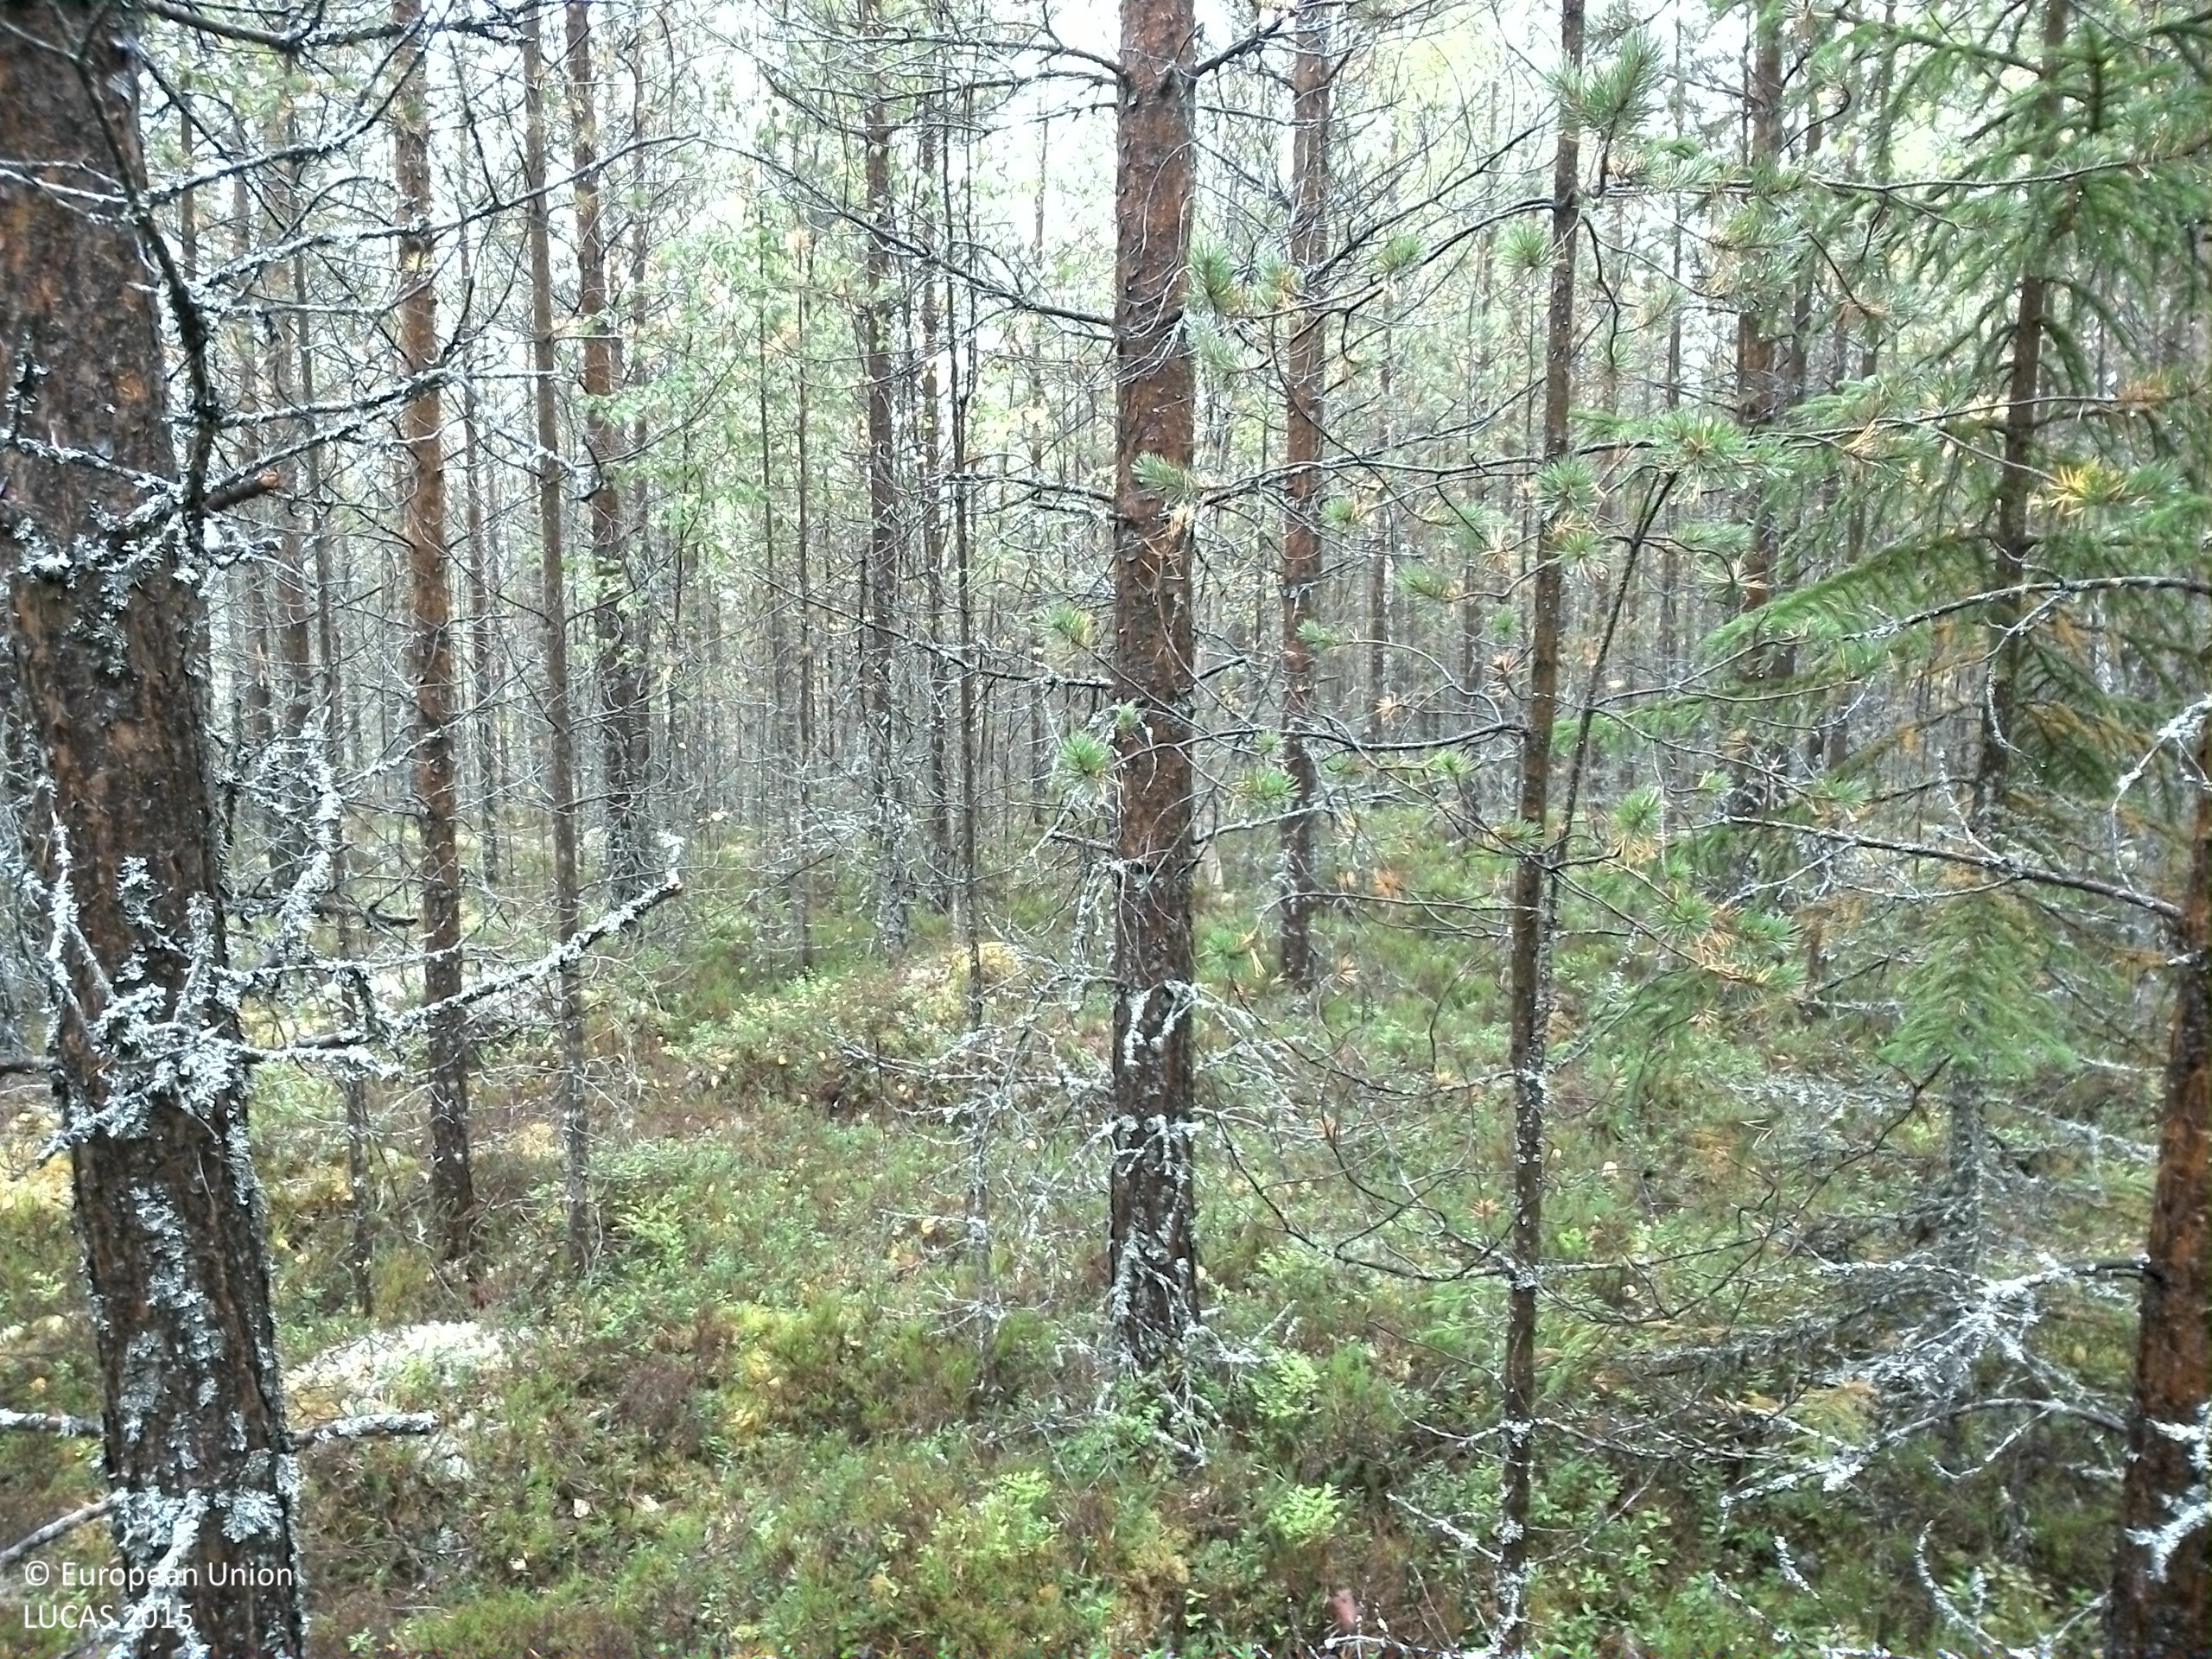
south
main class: Woodland
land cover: Pine dominated coniferous woodland
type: boreal forest
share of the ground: > 75 %
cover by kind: coniferous forest trees 75 %, shrubs 10 %, lichens and mosses 10 %, broadleaved forest trees 5 %
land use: Forestry
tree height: > 5 m
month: September
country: SE
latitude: 61.5126
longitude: 15.1526
